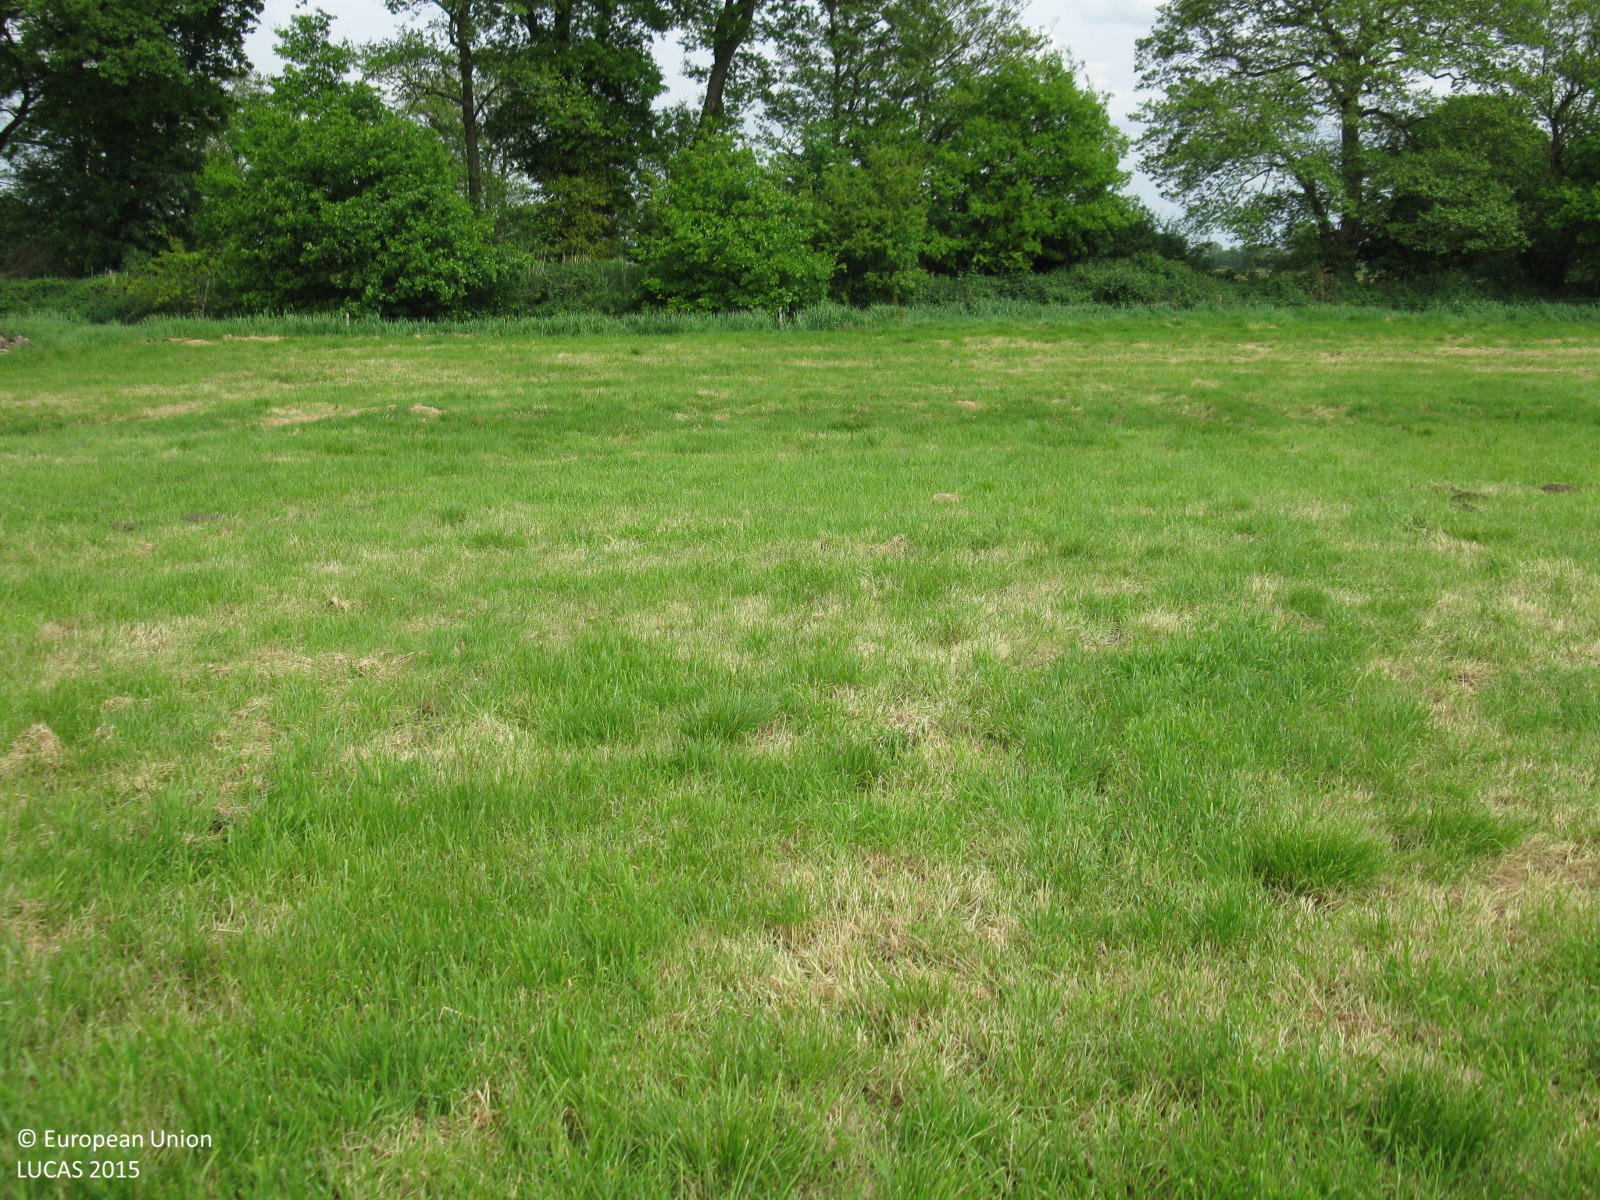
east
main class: Grassland
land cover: Grassland without tree/shrub cover
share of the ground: > 75 %
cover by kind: herbaceous plants 100 %
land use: Agriculture (excluding fallow land and kitchen gardens)
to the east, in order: Grassland without tree/shrub cover; Fences; Grass margins; Ditches and canals; Broadleaved woodland; Maize; Fences; Other fresh vegetables
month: June
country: DE
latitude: 53.1207
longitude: 7.3258
